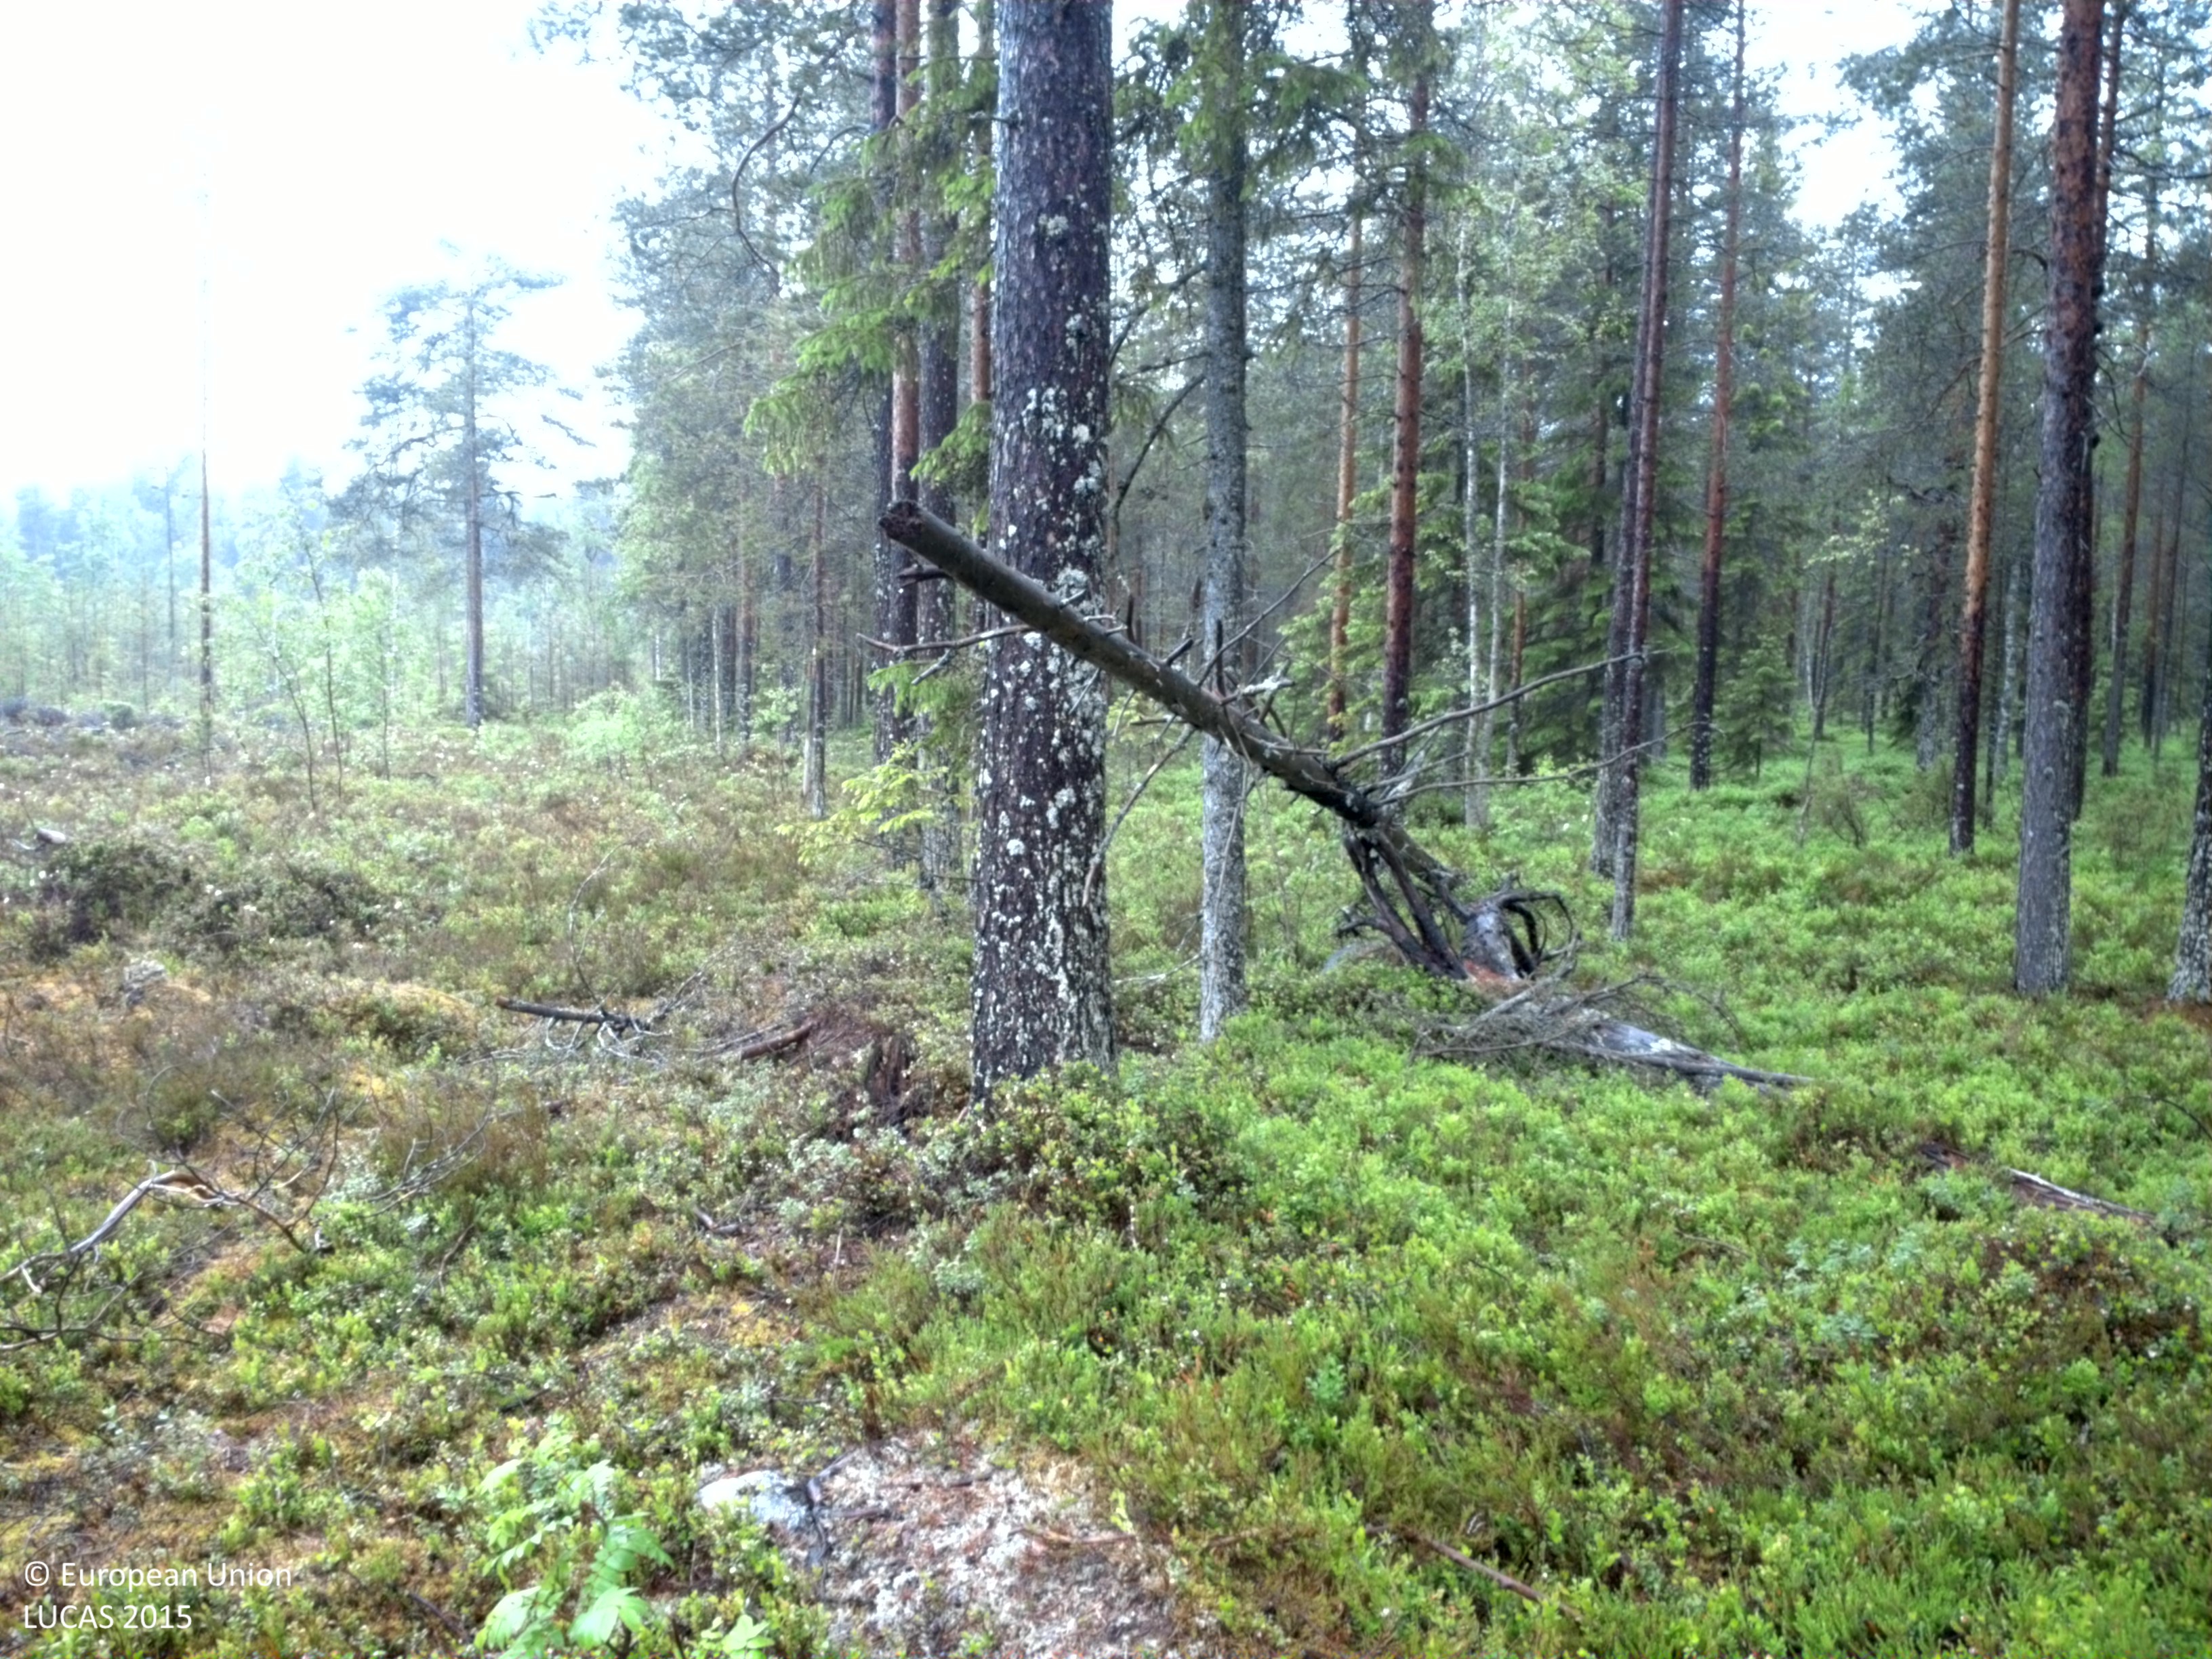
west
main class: Woodland
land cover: Other coniferous woodland
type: boreal forest
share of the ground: 50 - 75 %
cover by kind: coniferous forest trees 60 %, shrubs 20 %, broadleaved forest trees 15 %, lichens and mosses 5 %
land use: Forestry
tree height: > 5 m
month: June
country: SE
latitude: 64.3511
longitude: 20.8935
